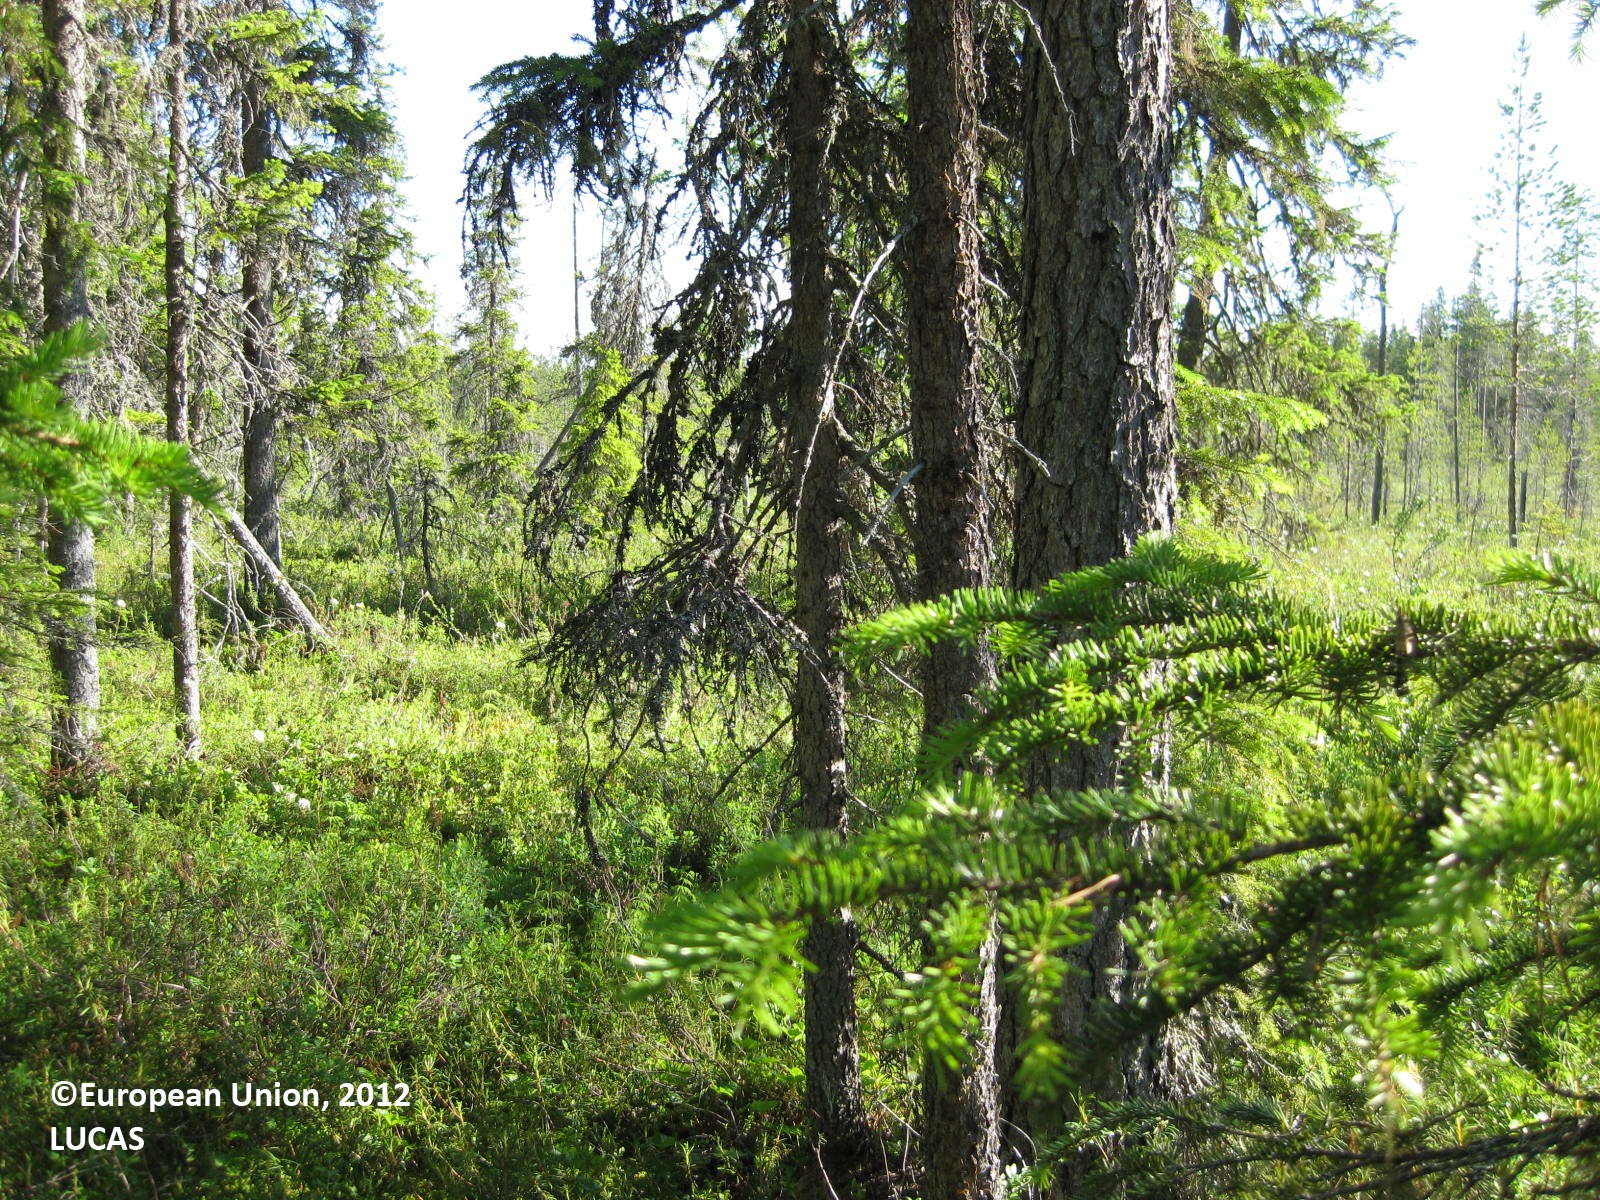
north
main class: Woodland
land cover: Spruce dominated coniferous woodland
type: mire and swamp forests
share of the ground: 50 - 75 %
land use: Forestry
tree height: > 5 m
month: July
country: FI
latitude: 65.5518
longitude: 29.4910
